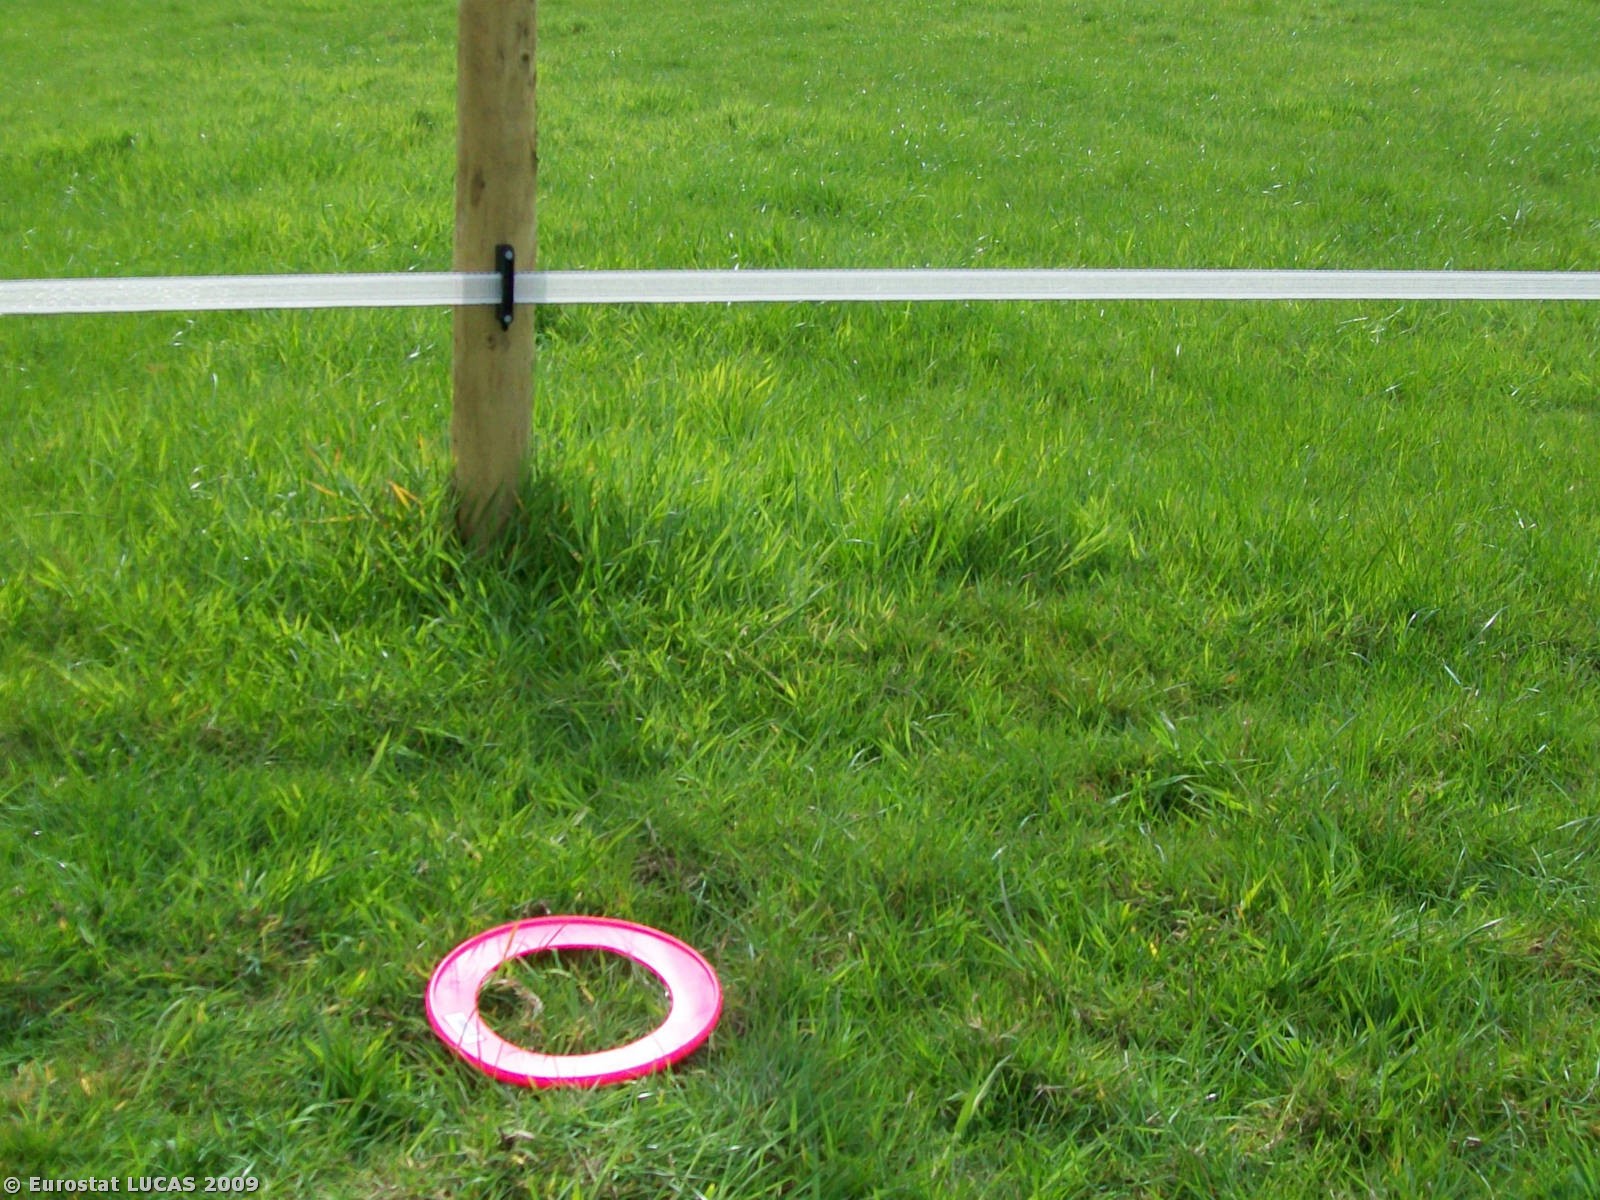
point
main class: Grassland
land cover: Grassland without tree/shrub cover
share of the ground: 50 - 75 %
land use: Agriculture (excluding fallow land and kitchen gardens)
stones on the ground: < 10 %
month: April
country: GB
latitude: 53.5447
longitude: -2.9153
